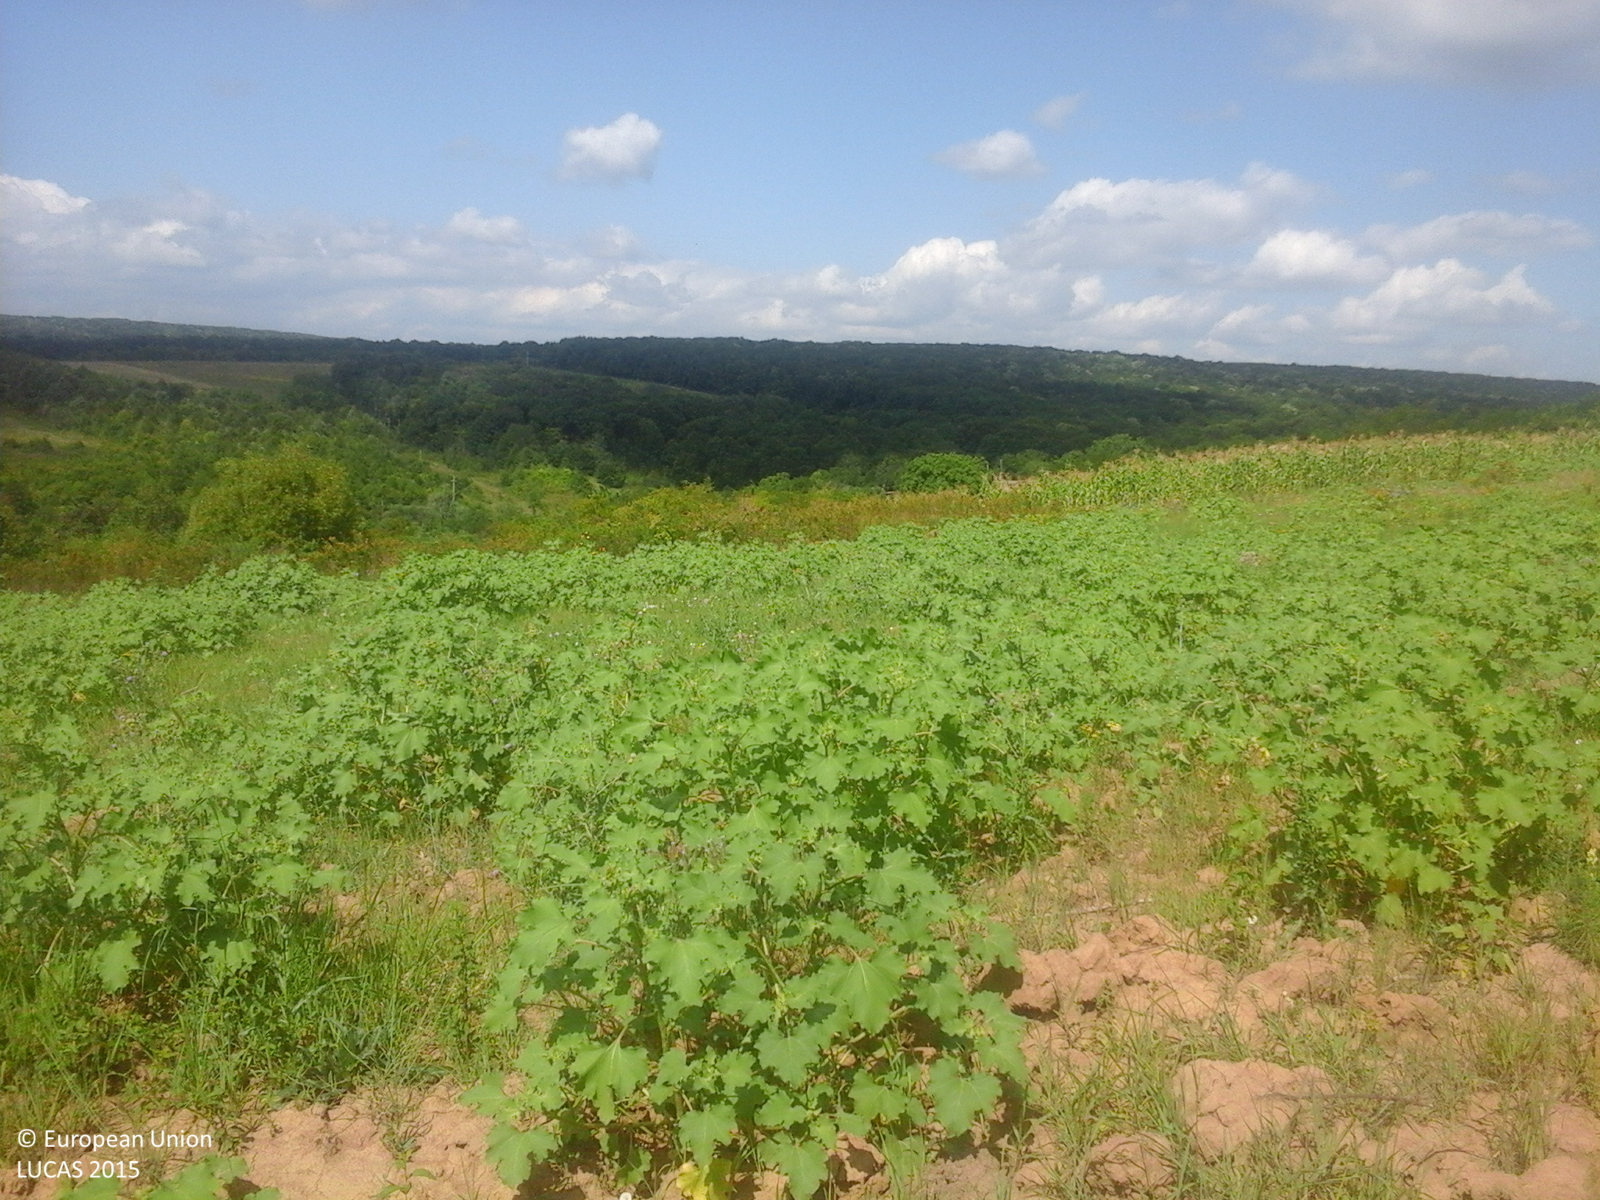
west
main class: Shrubland
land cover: Shrubland without tree cover
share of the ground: > 75 %
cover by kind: shrubs 100 %
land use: Fallow land
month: July
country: RO
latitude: 46.5705
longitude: 27.9342
